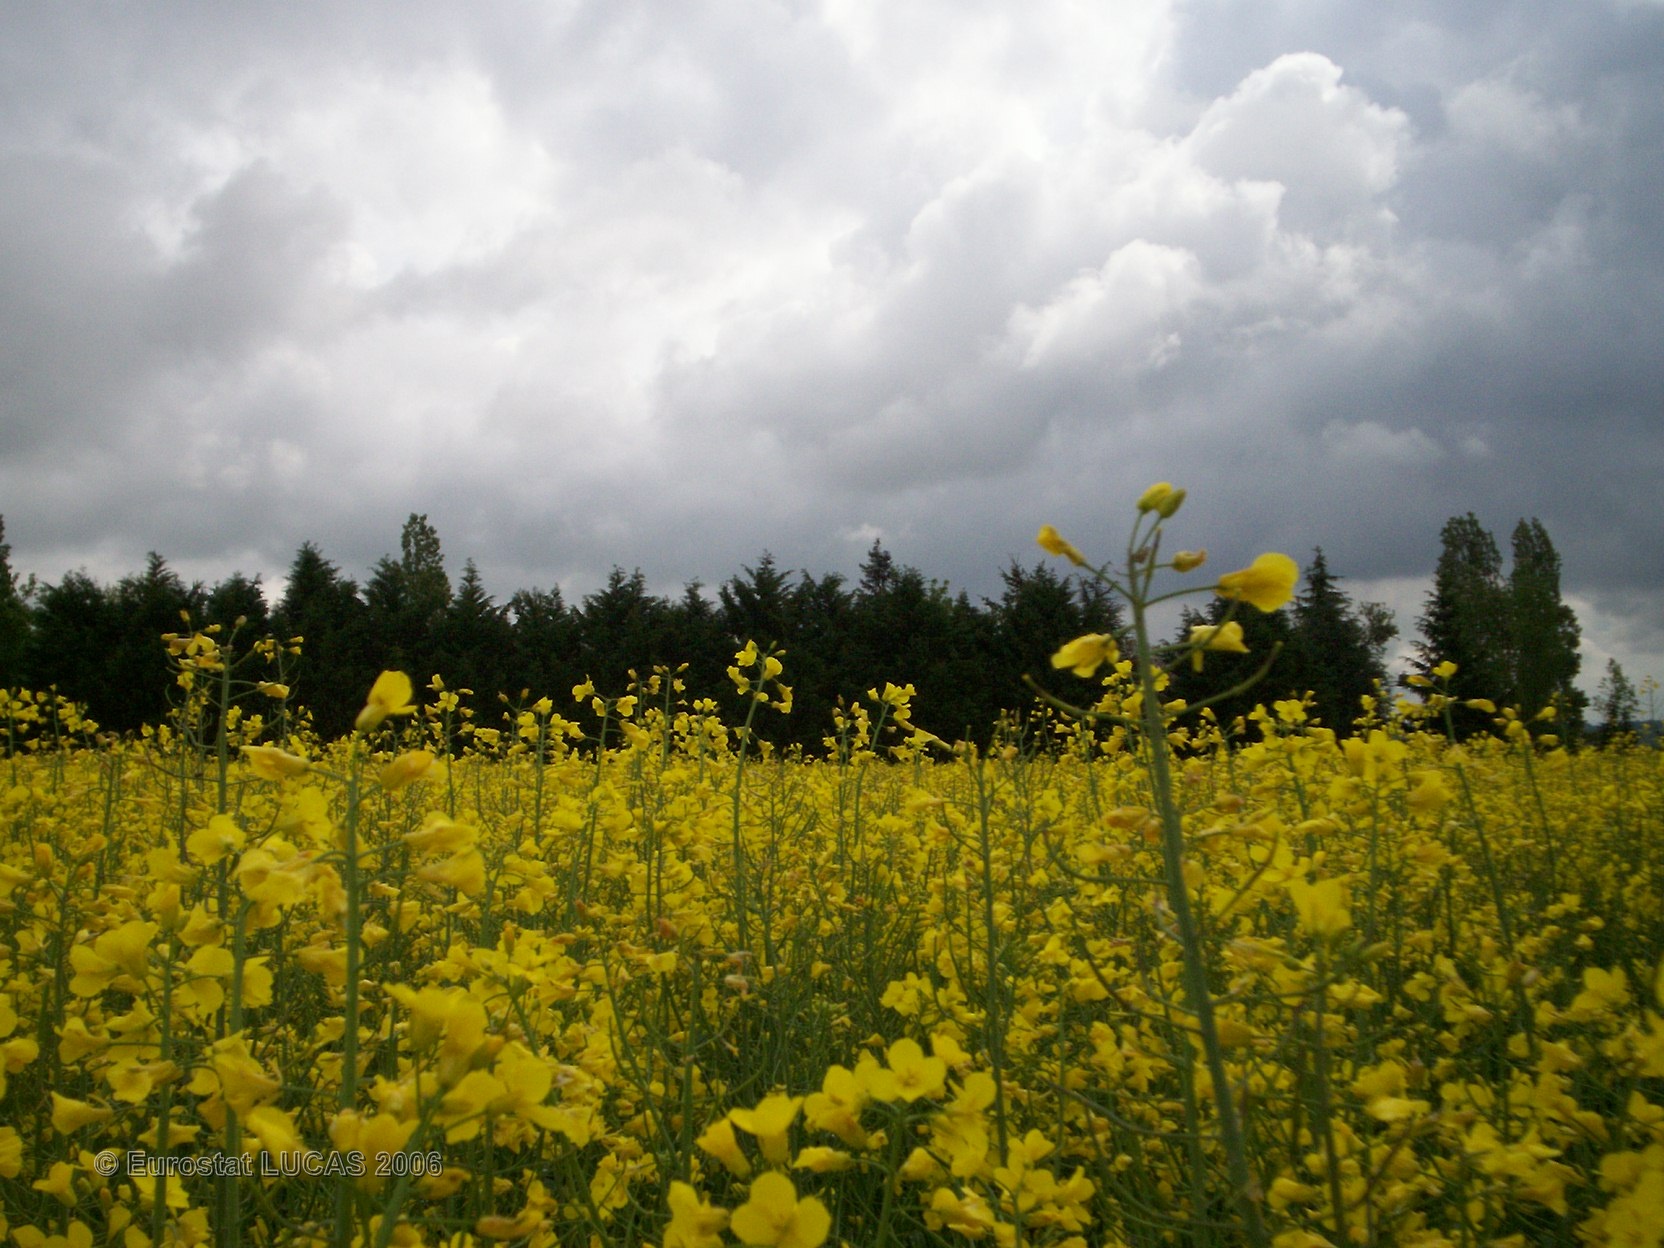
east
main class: Cropland
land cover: Rape and turnip rape
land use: Agriculture (excluding fallow land and kitchen gardens)
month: May
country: FR
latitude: 47.9445
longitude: 2.9641
